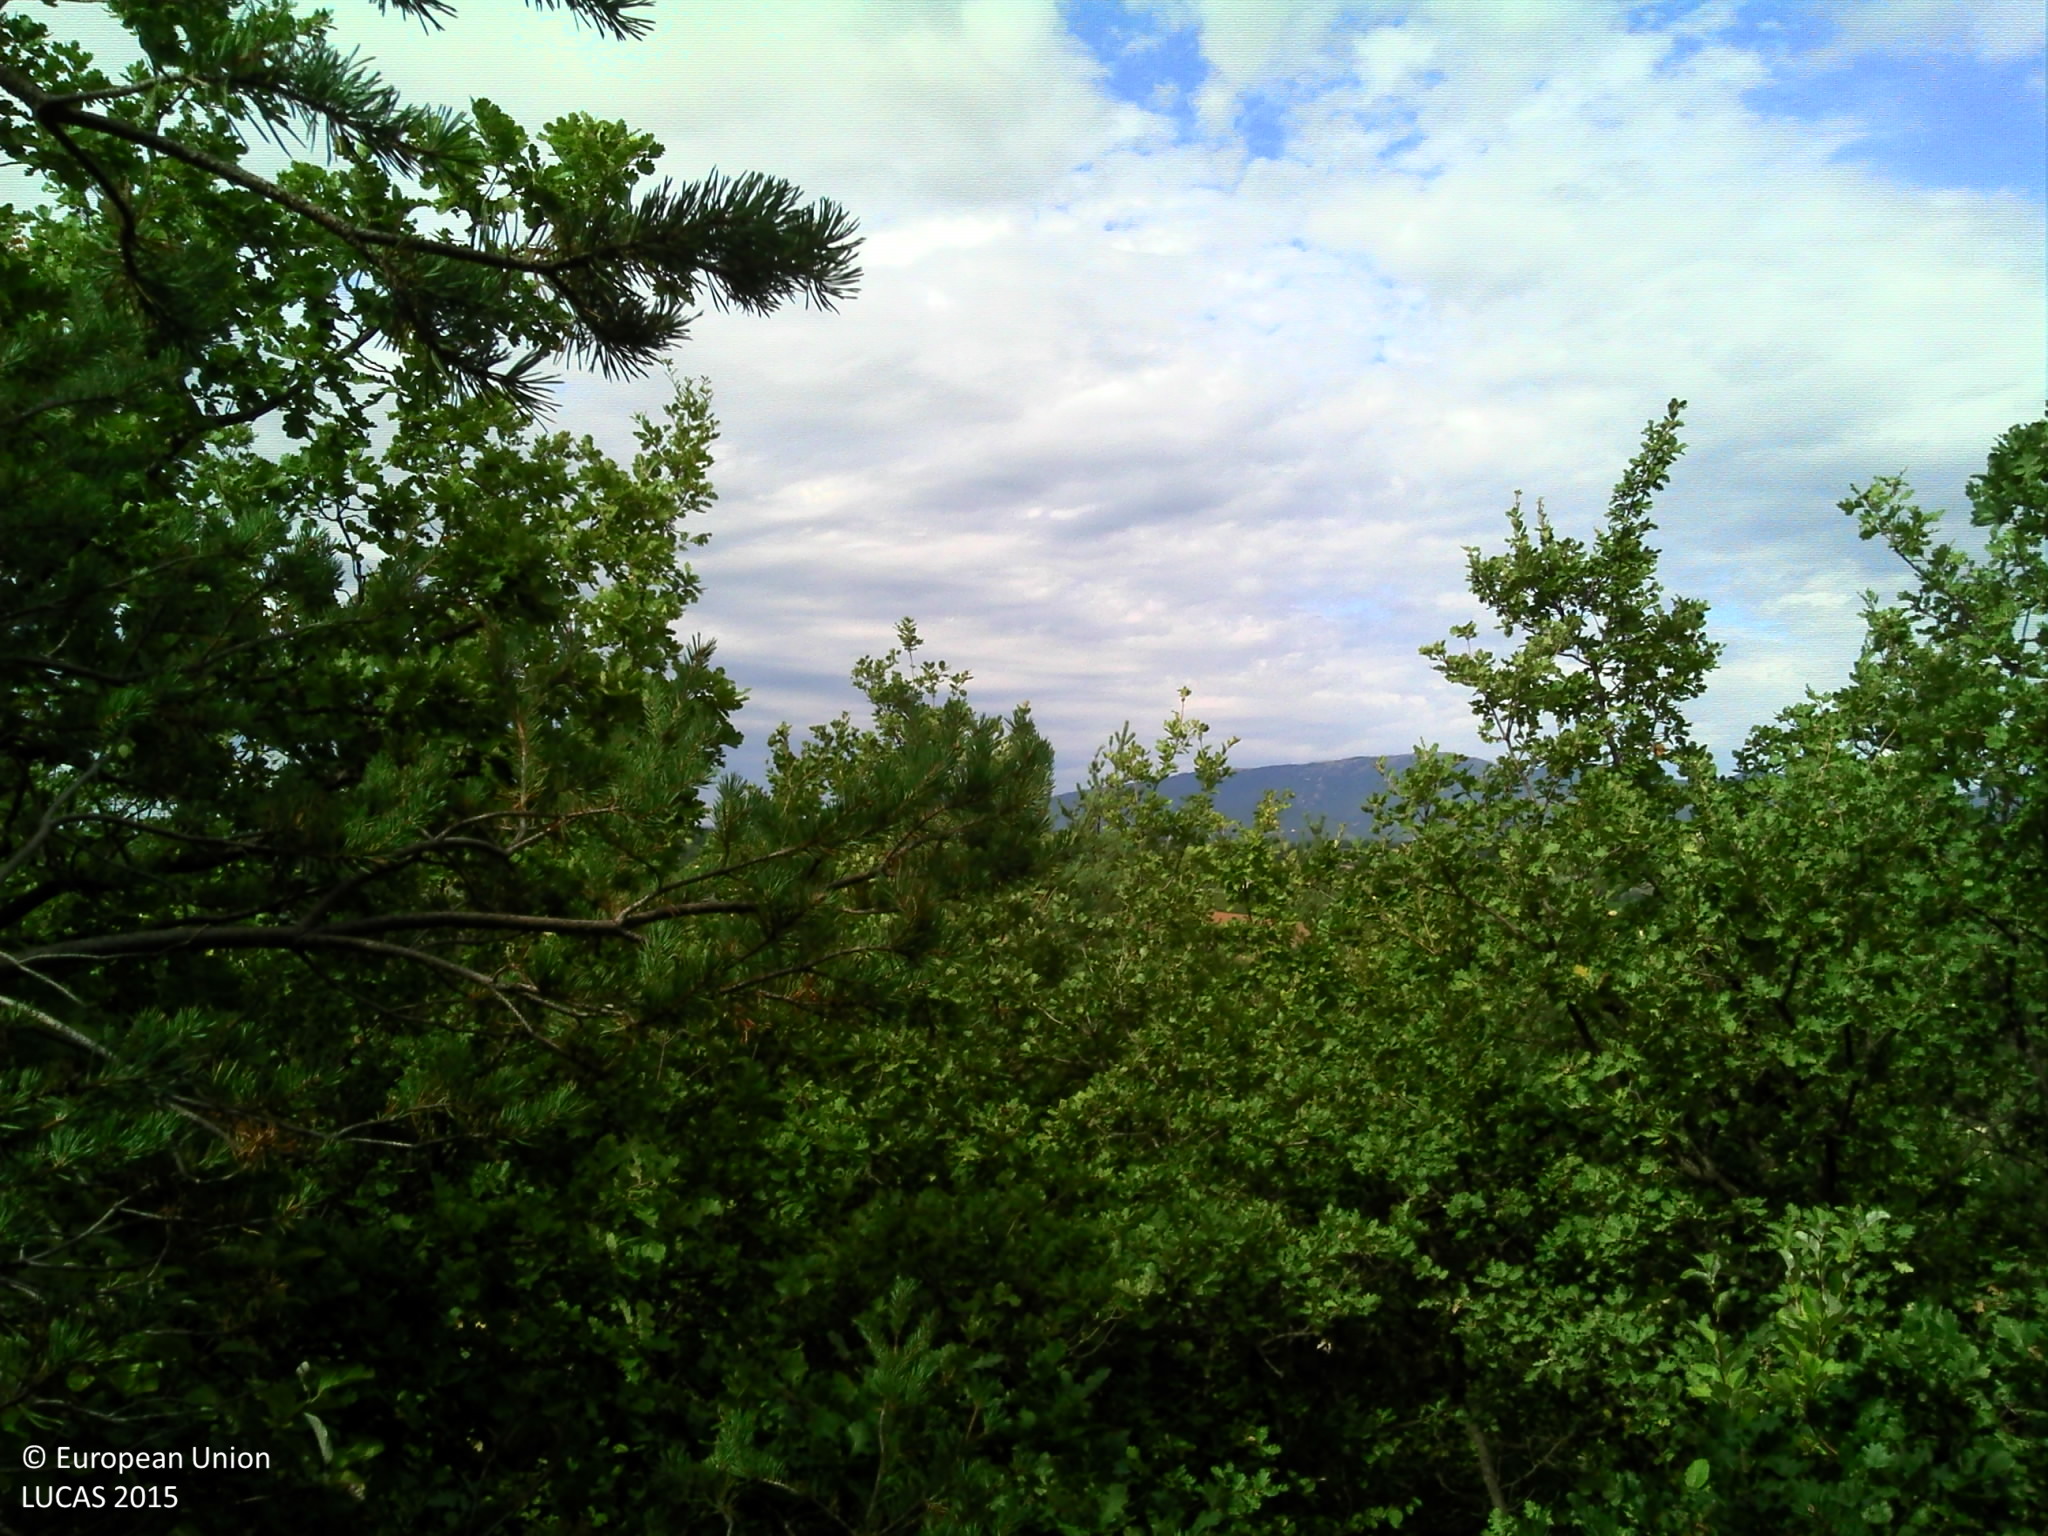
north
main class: Woodland
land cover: Pine dominated mixed woodland
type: coniferous forest of the mediterranean region
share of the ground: > 75 %
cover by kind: broadleaved forest trees 55 %, coniferous forest trees 25 %, shrubs 10 %, herbaceous plants 10 %
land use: Forestry
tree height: > 5 m
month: September
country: FR
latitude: 44.3398
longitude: 5.0280
